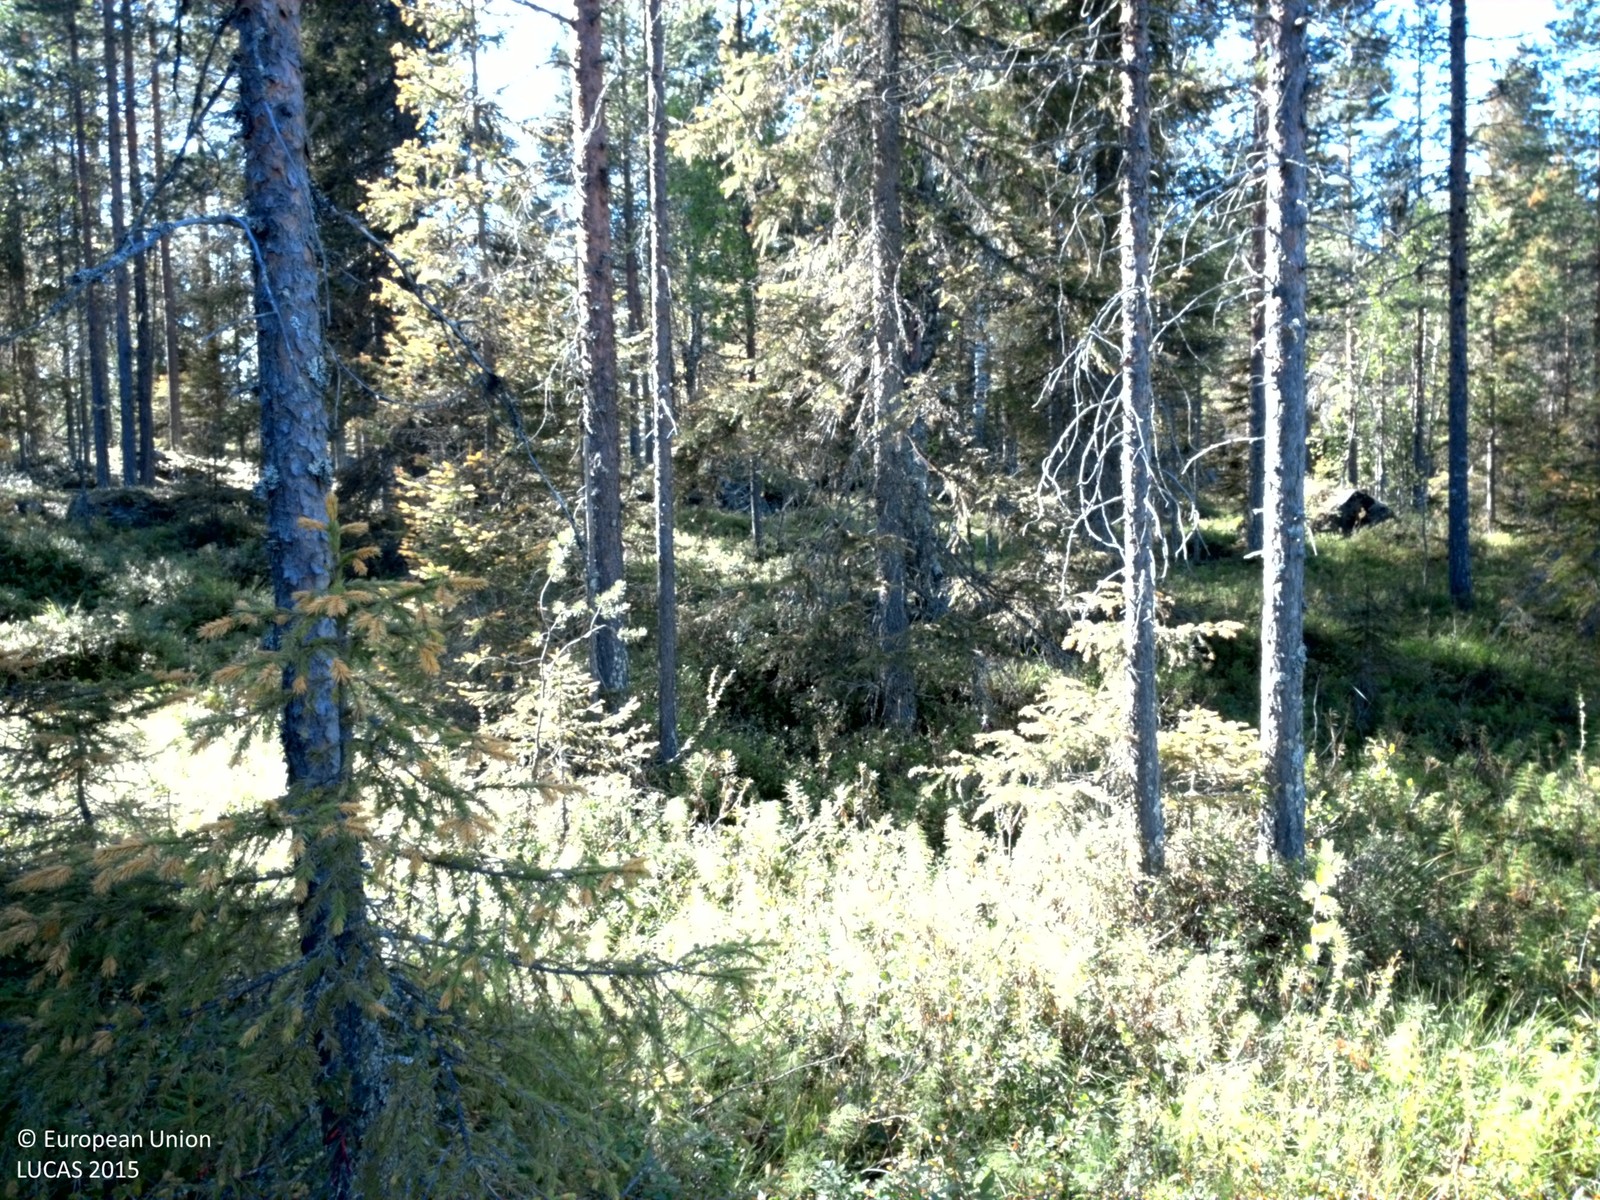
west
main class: Woodland
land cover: Pine dominated coniferous woodland
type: boreal forest
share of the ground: 25 - 50 %
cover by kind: shrubs 65 %, coniferous forest trees 30 %, lichens and mosses 5 %
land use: Forestry
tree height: > 5 m
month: August
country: SE
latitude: 66.1136
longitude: 22.6153
